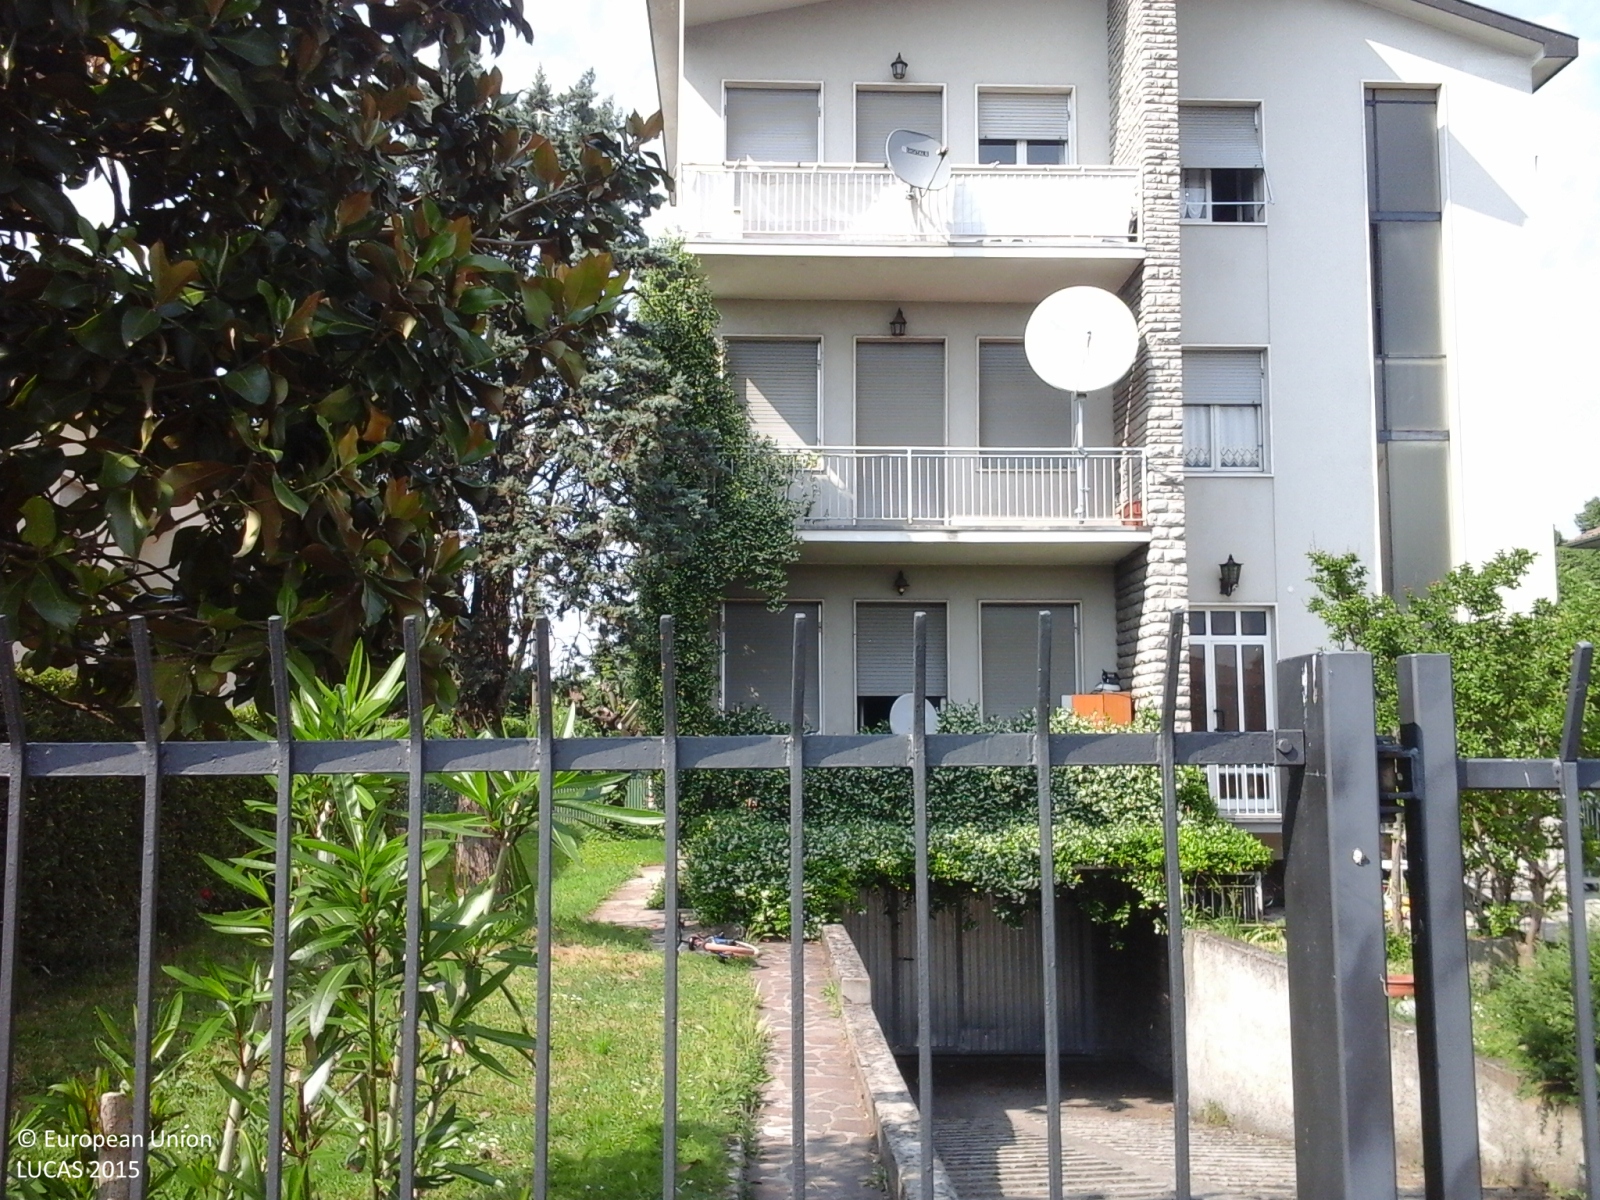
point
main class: Grassland
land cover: Grassland with sparse tree/shrub cover
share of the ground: > 75 %
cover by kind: herbaceous plants 90 %, broadleaved forest trees 5 %, shrubs 5 %
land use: Residential
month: May
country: IT
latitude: 45.6480
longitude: 9.6541
